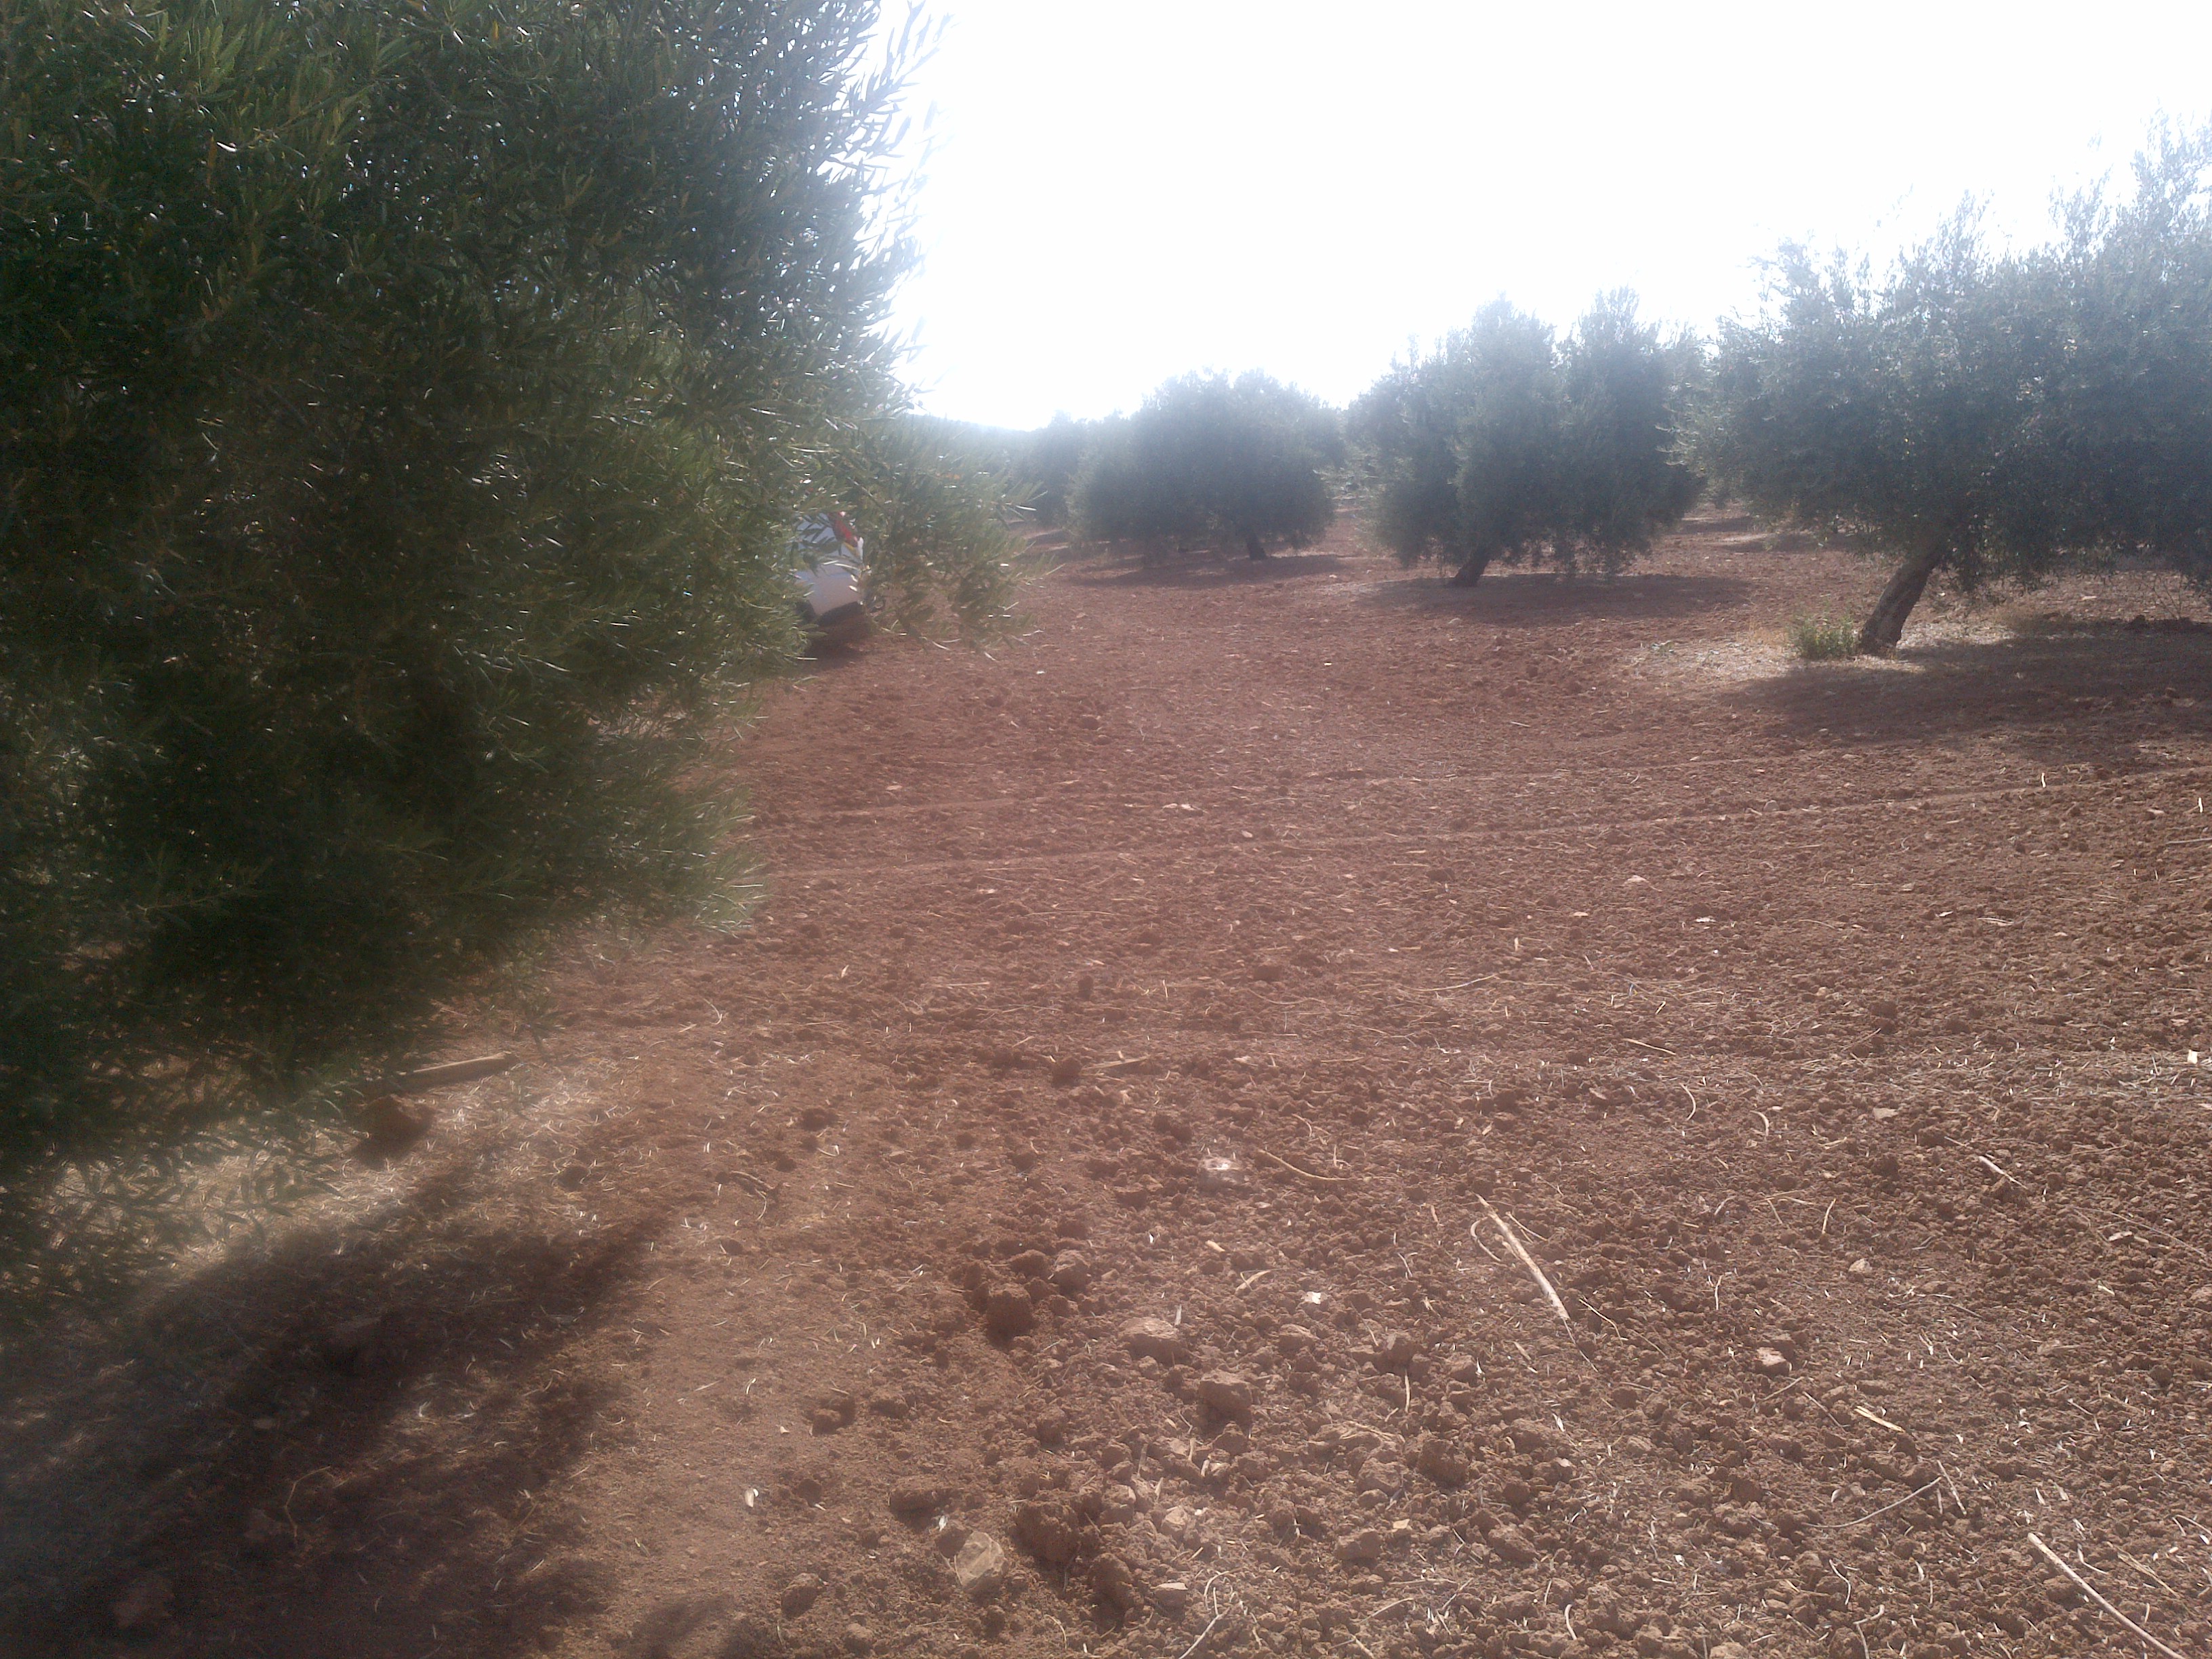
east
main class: Cropland
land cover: Olive groves
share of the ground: 50 - 75 %
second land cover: Other bare soil
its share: > 75 %
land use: Agriculture (excluding fallow land and kitchen gardens)
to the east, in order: Olive groves; Other bare soil
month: June
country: ES
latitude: 37.6994
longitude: -4.2384
